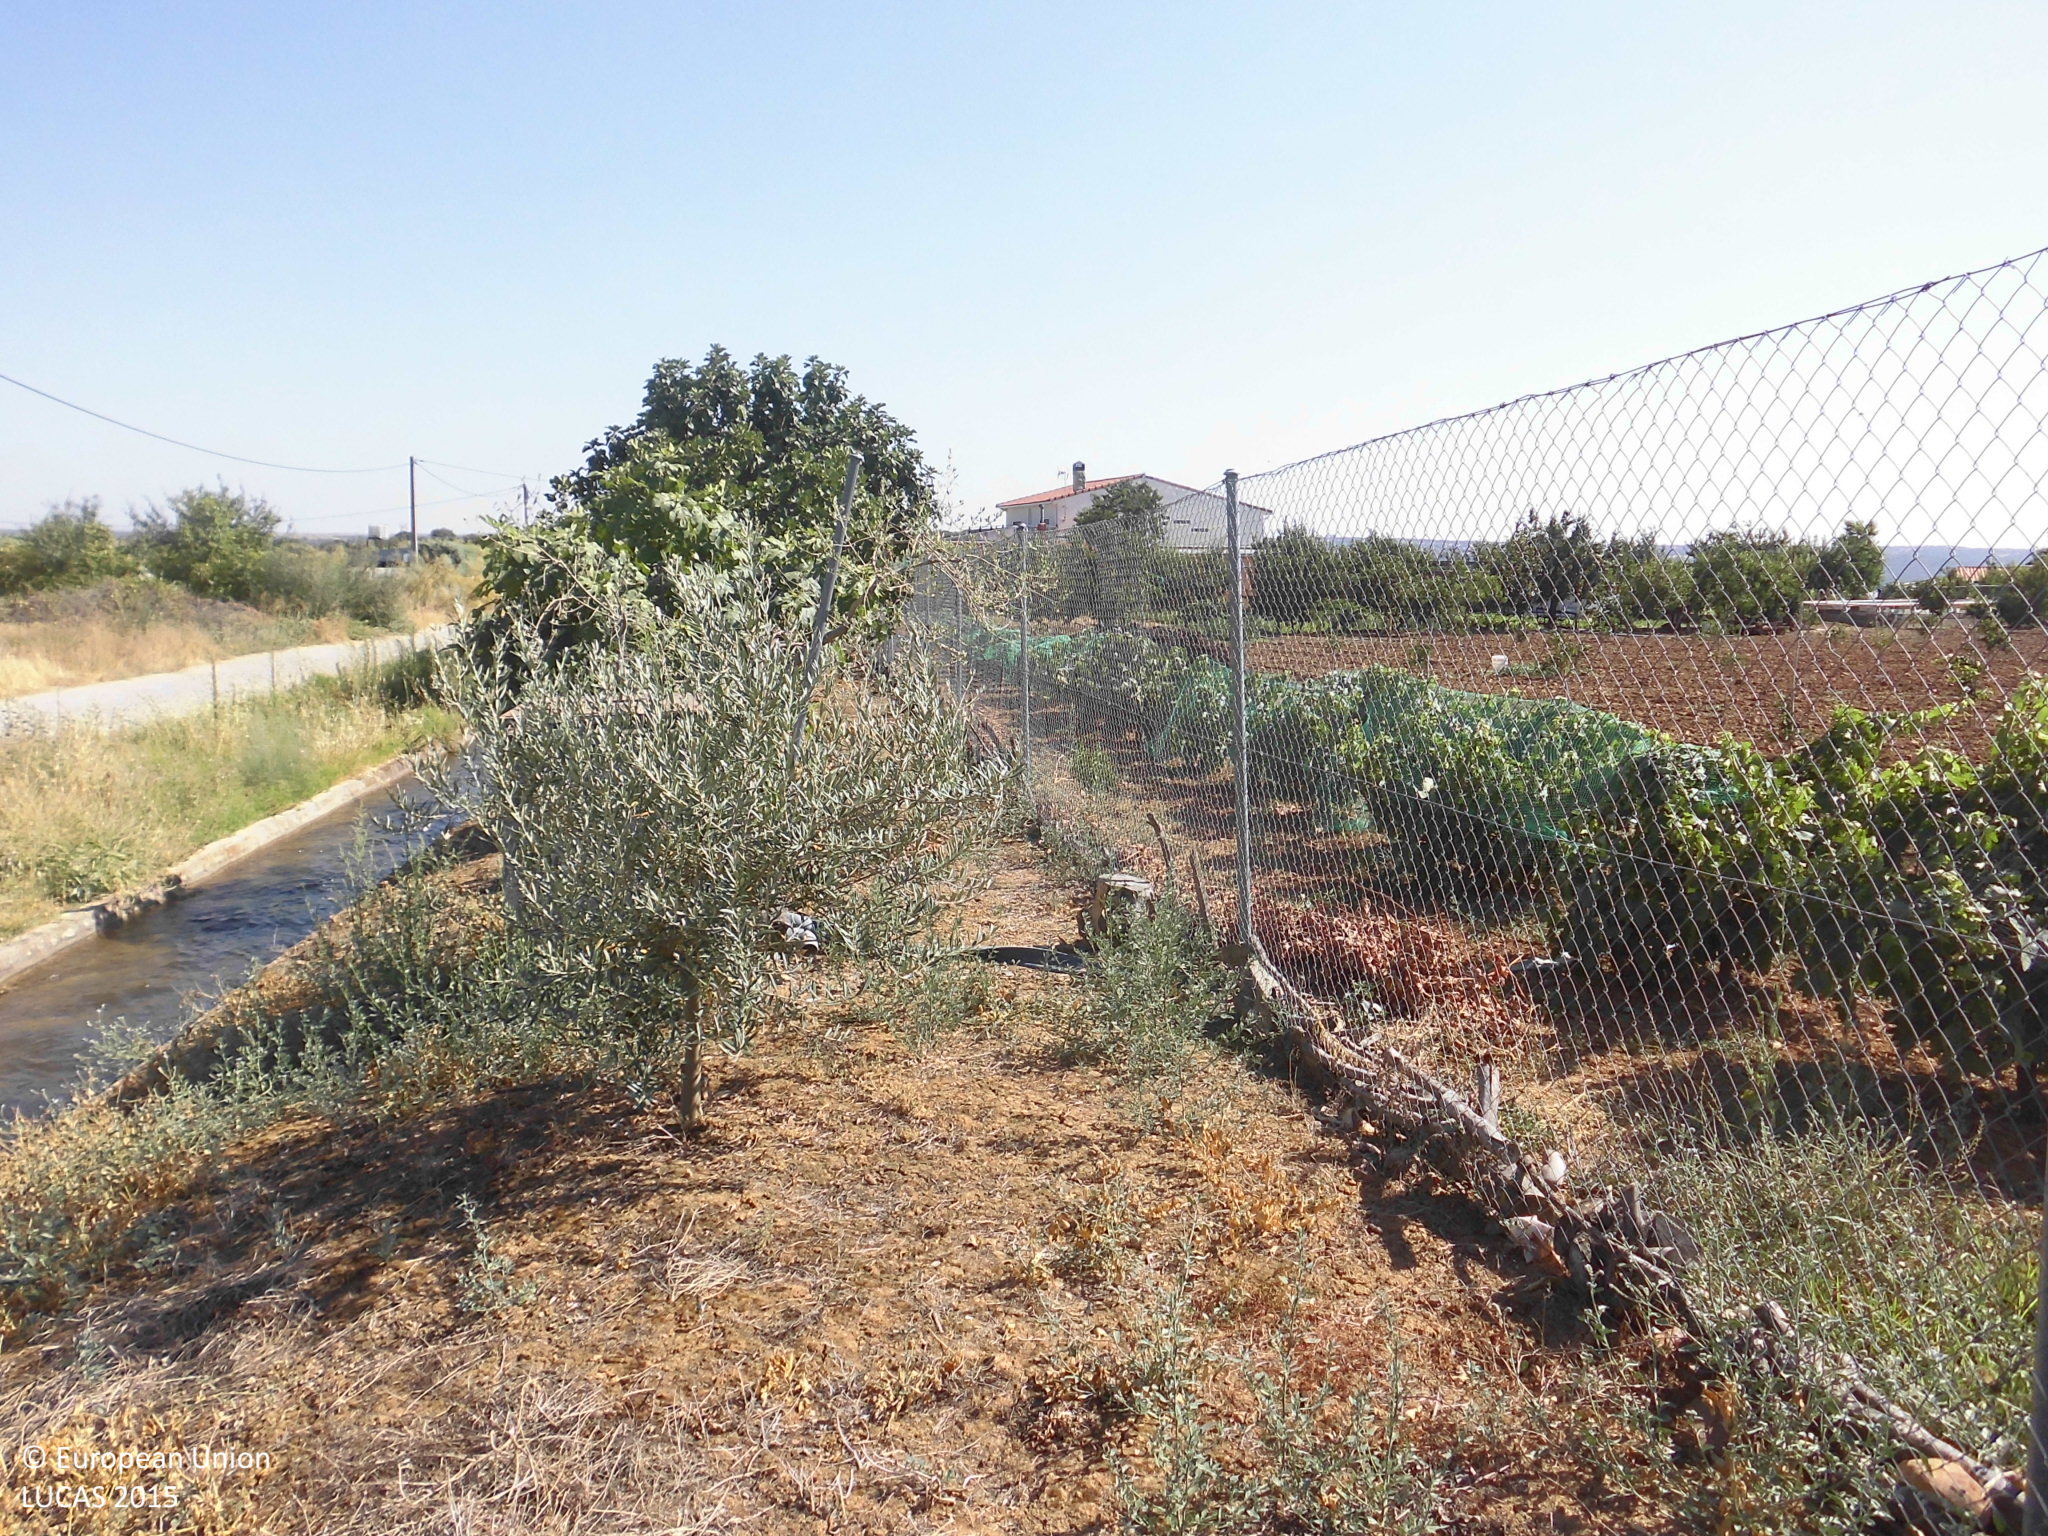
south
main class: Cropland
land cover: Olive groves
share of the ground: < 10 %
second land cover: Other bare soil
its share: > 75 %
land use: Agriculture (excluding fallow land and kitchen gardens)
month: July
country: ES
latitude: 39.9913
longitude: -6.5590
